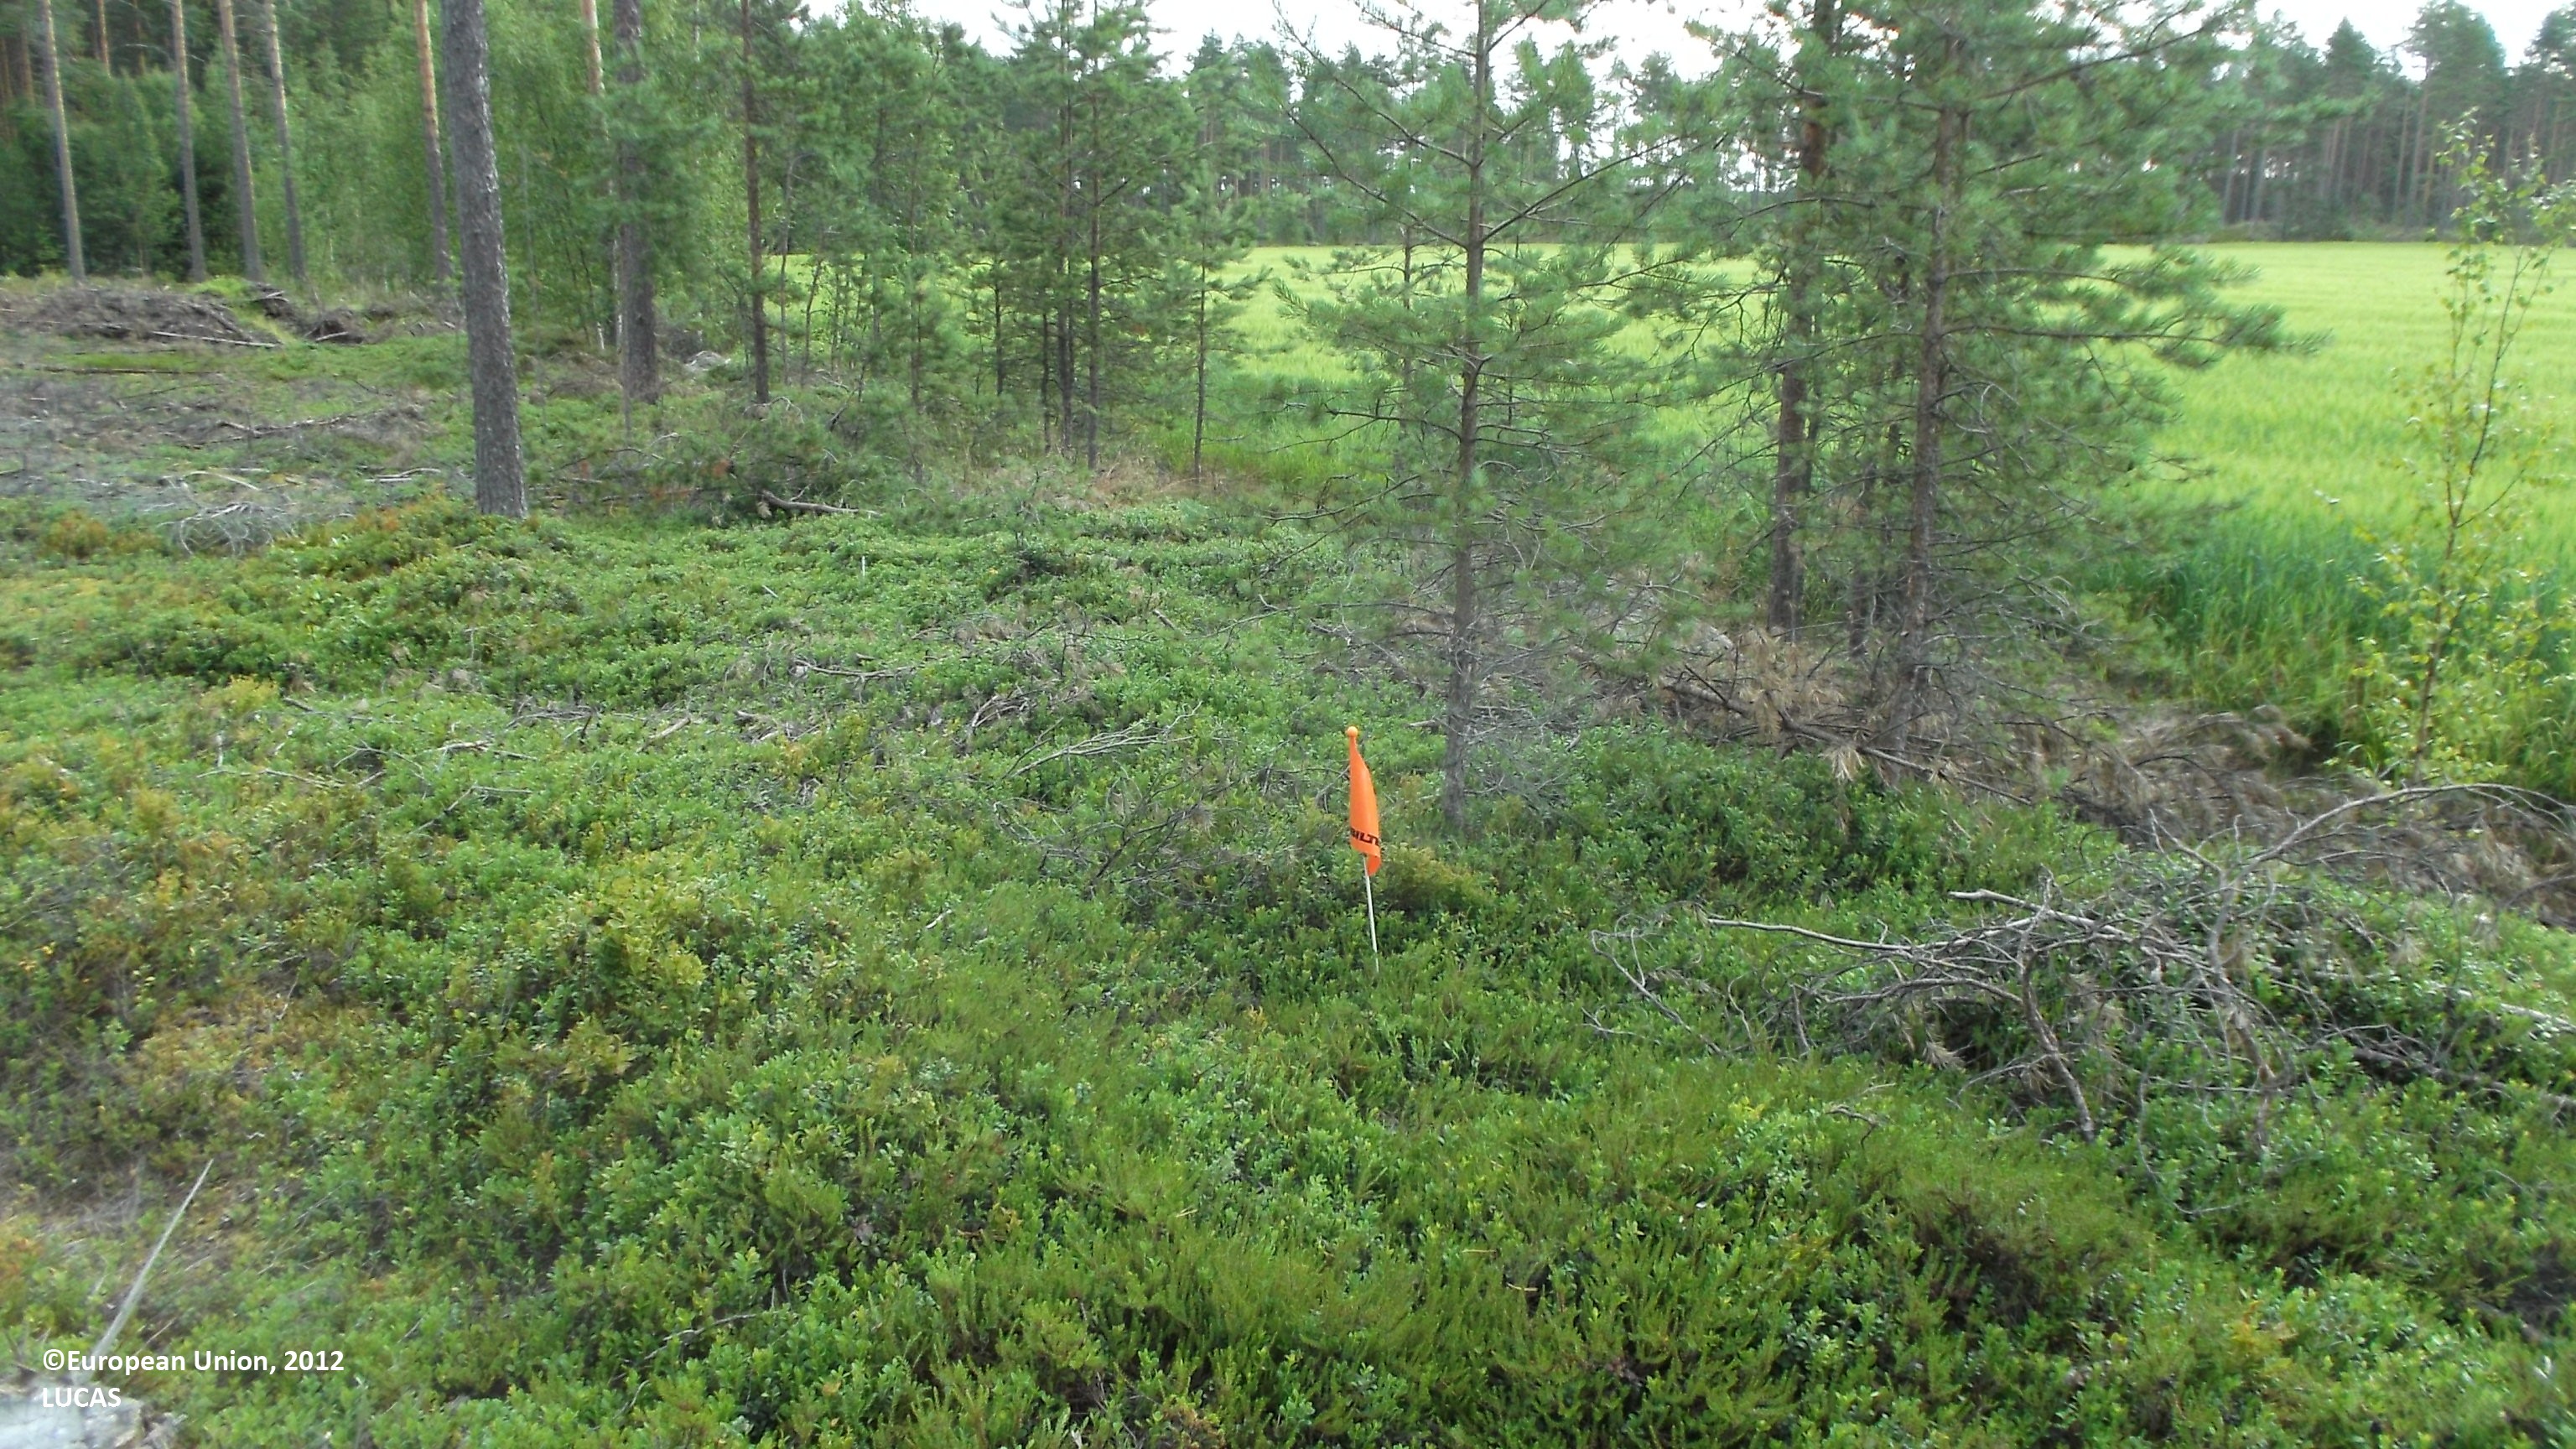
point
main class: Woodland
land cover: Pine dominated coniferous woodland
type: boreal forest
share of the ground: 10 - 25 %
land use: Forestry
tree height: > 5 m
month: July
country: FI
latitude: 63.9707
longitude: 23.4343
